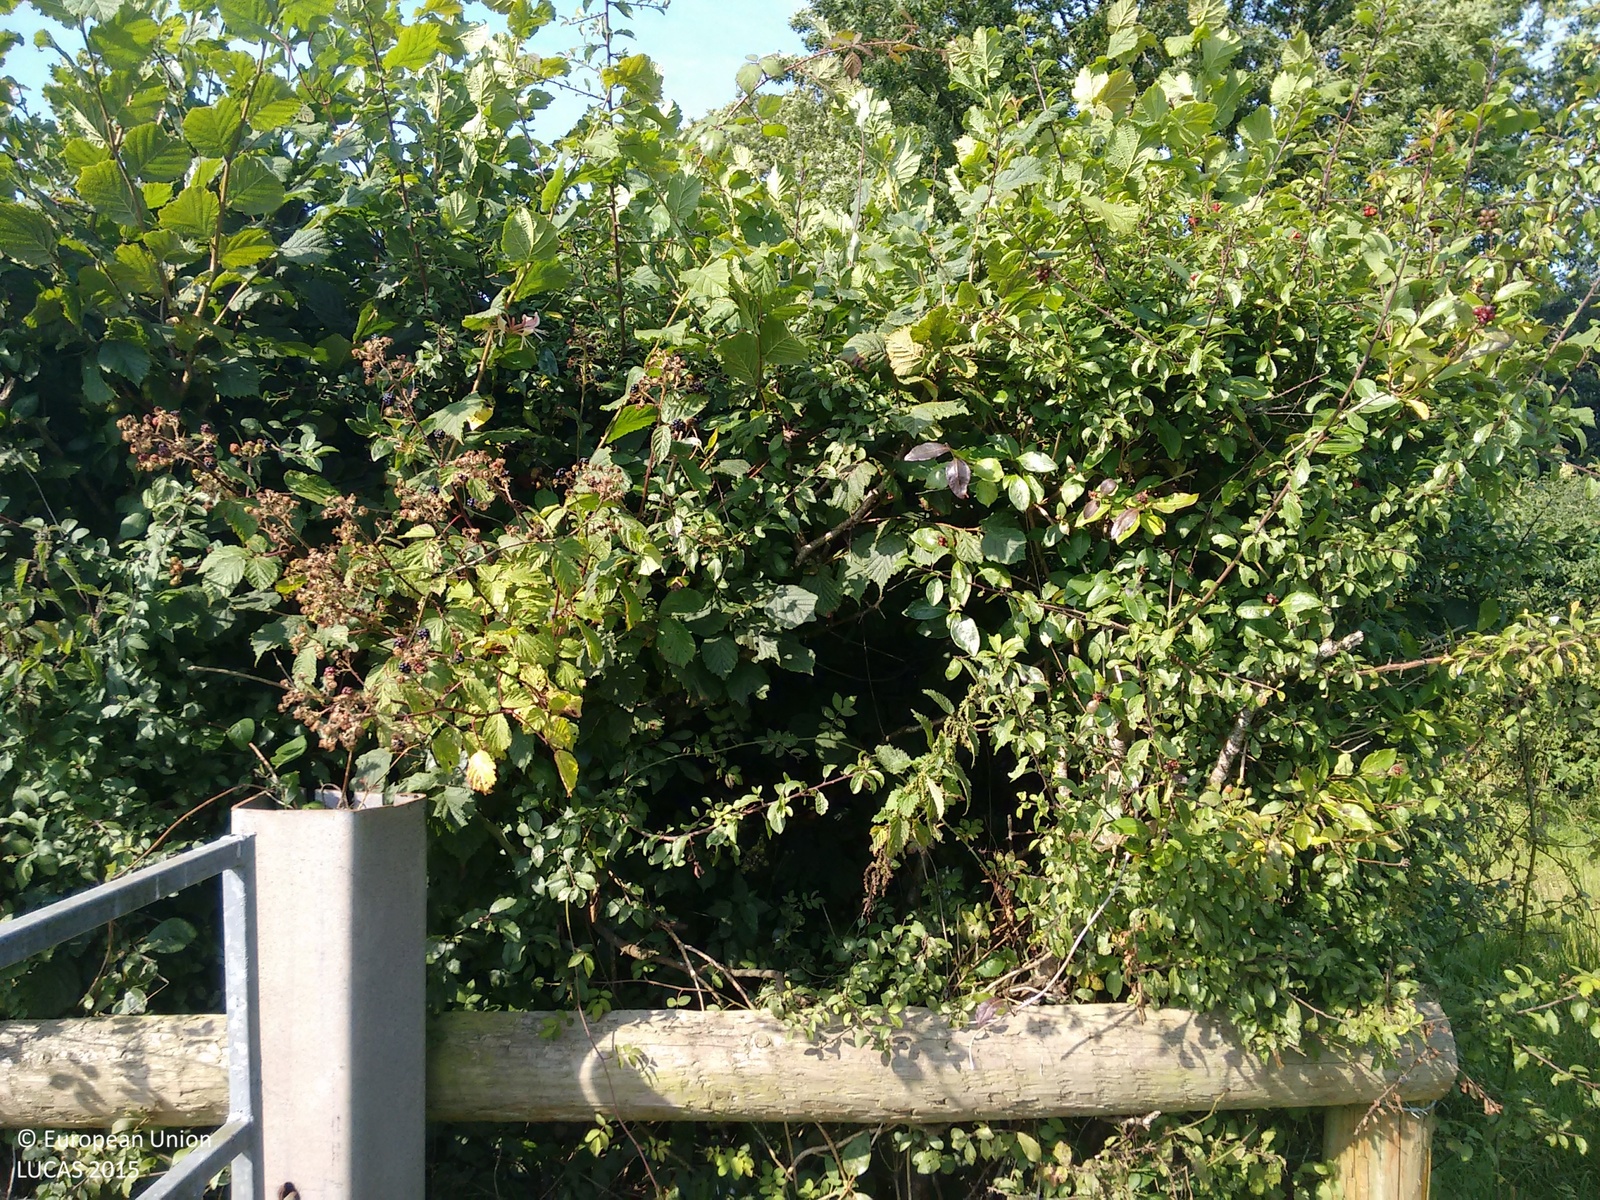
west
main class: Grassland
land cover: Grassland without tree/shrub cover
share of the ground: > 75 %
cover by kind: herbaceous plants 100 %
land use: Agriculture (excluding fallow land and kitchen gardens)
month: September
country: GB
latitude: 50.8351
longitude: -4.4014
